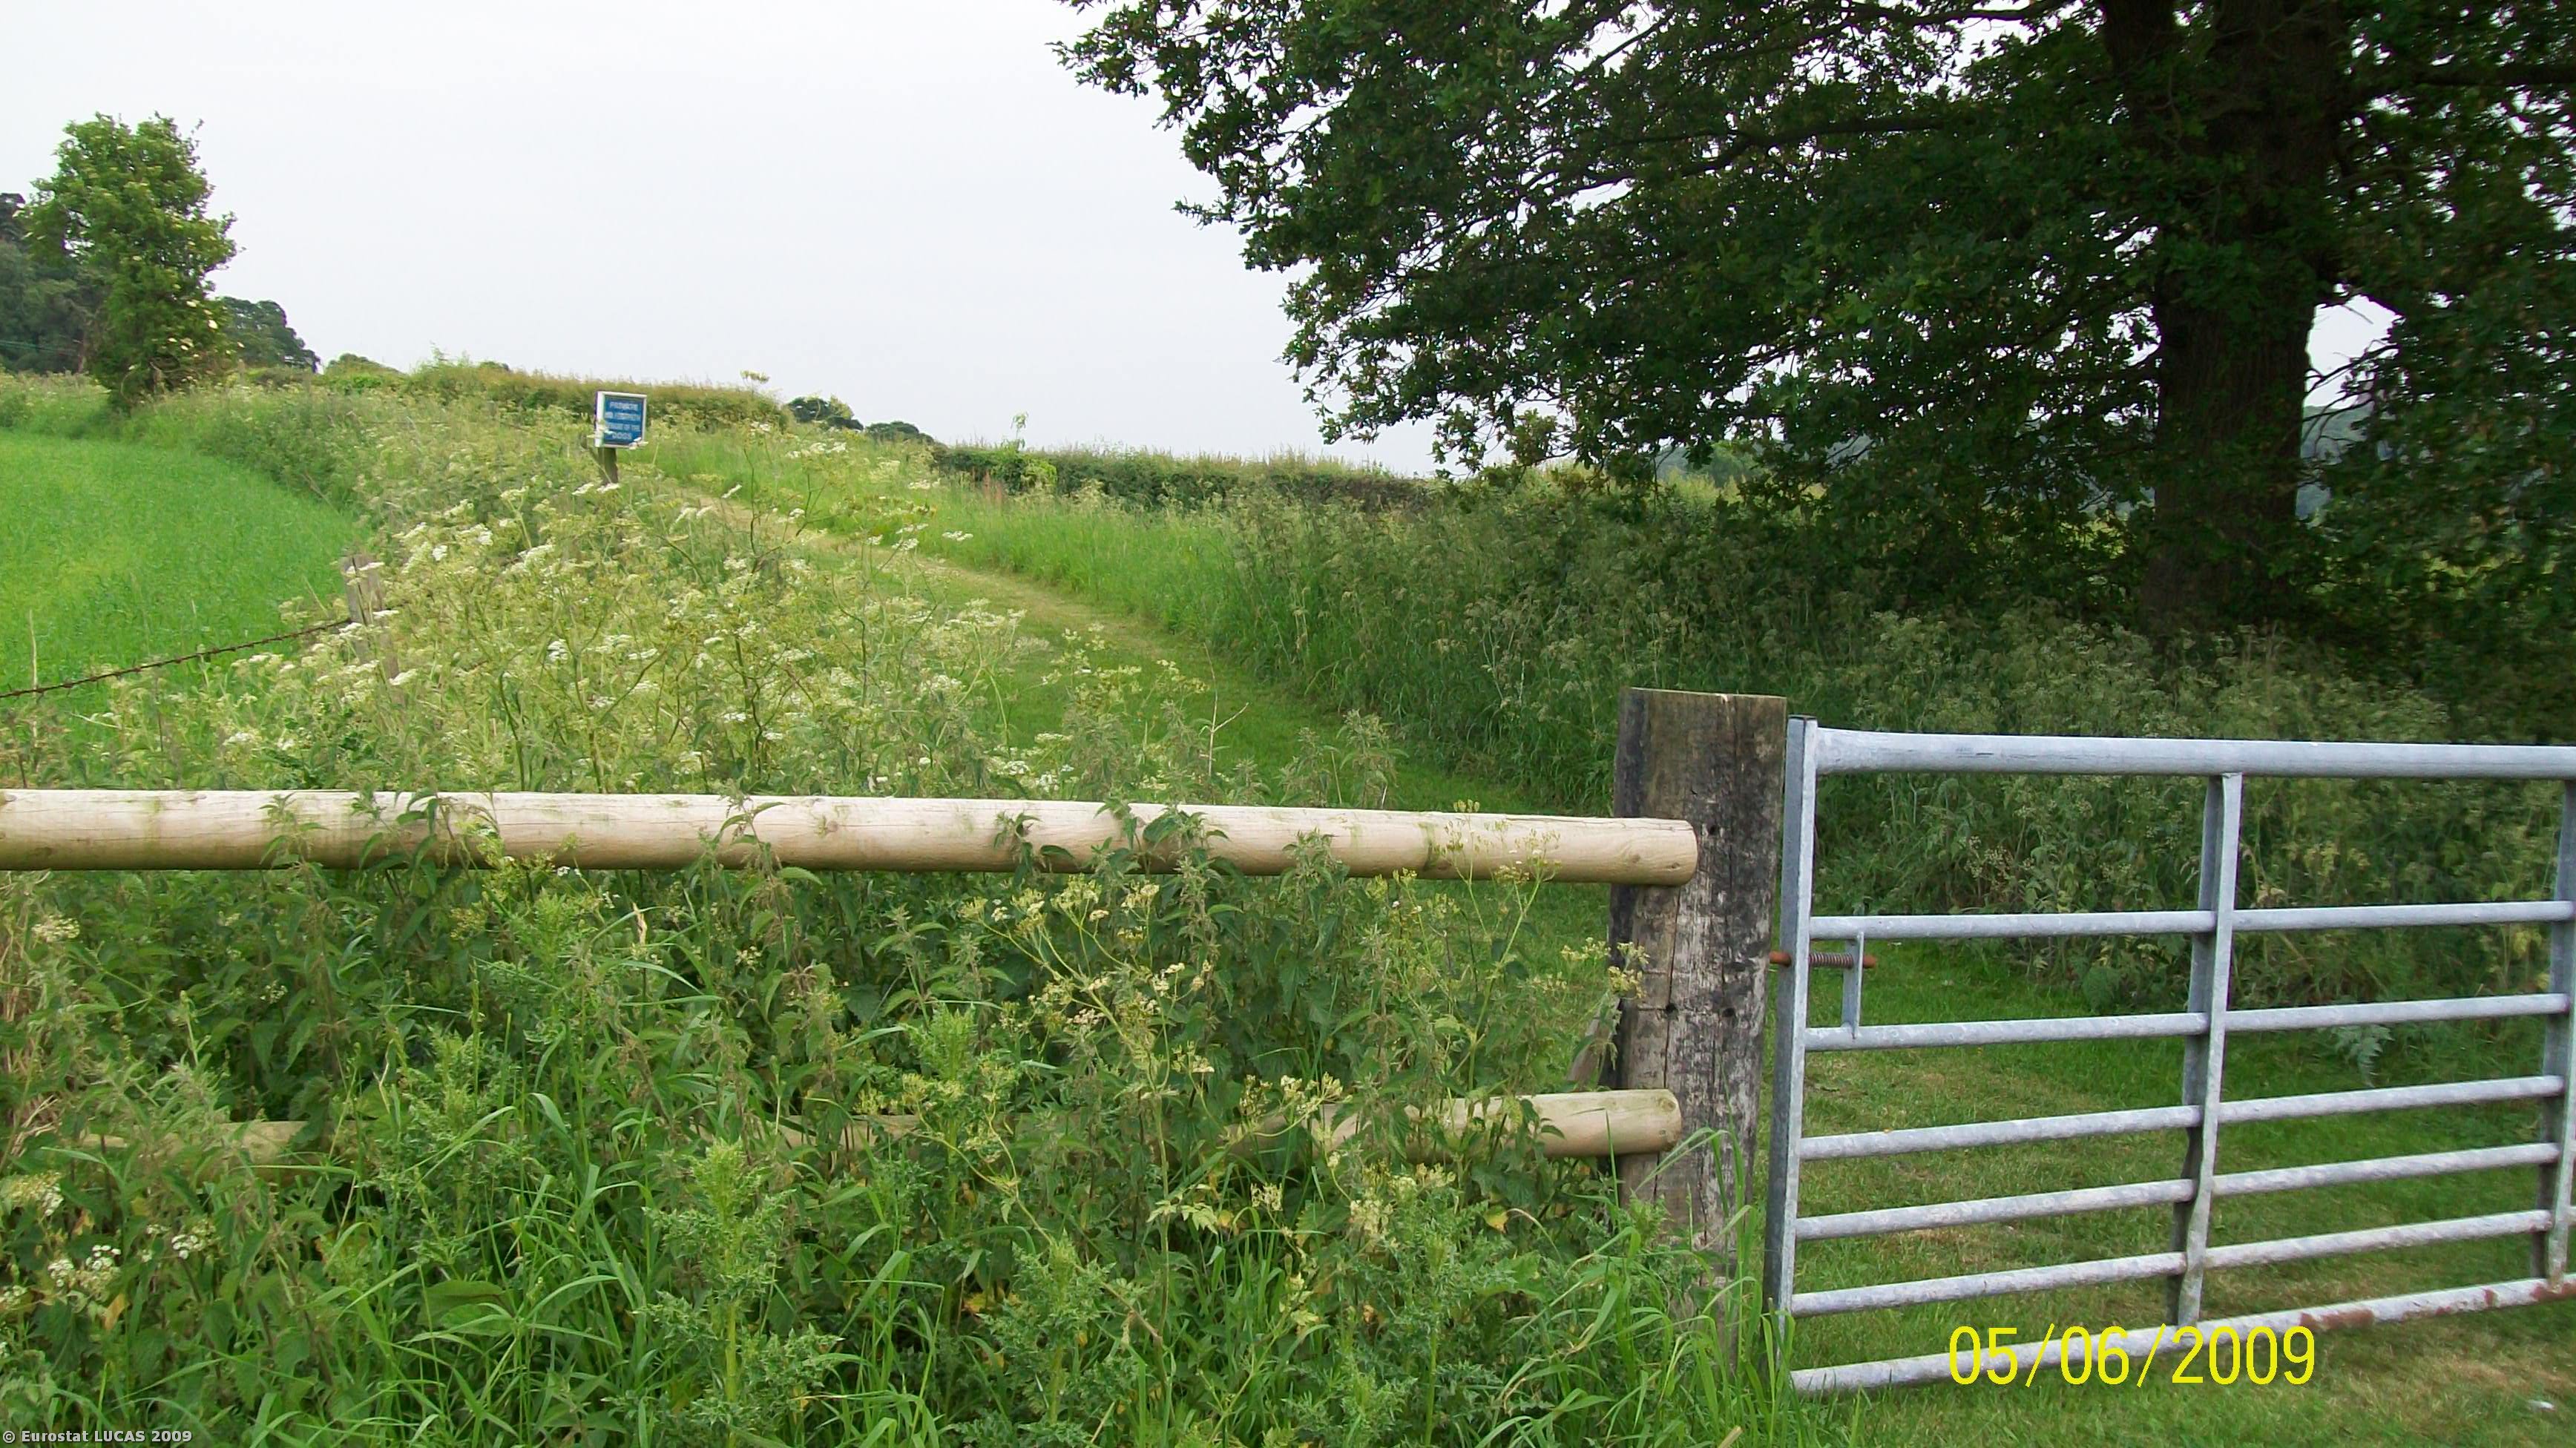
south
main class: Cropland
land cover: Barley
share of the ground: > 75 %
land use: Agriculture (excluding fallow land and kitchen gardens)
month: June
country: GB
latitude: 53.1306
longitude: -2.6984
